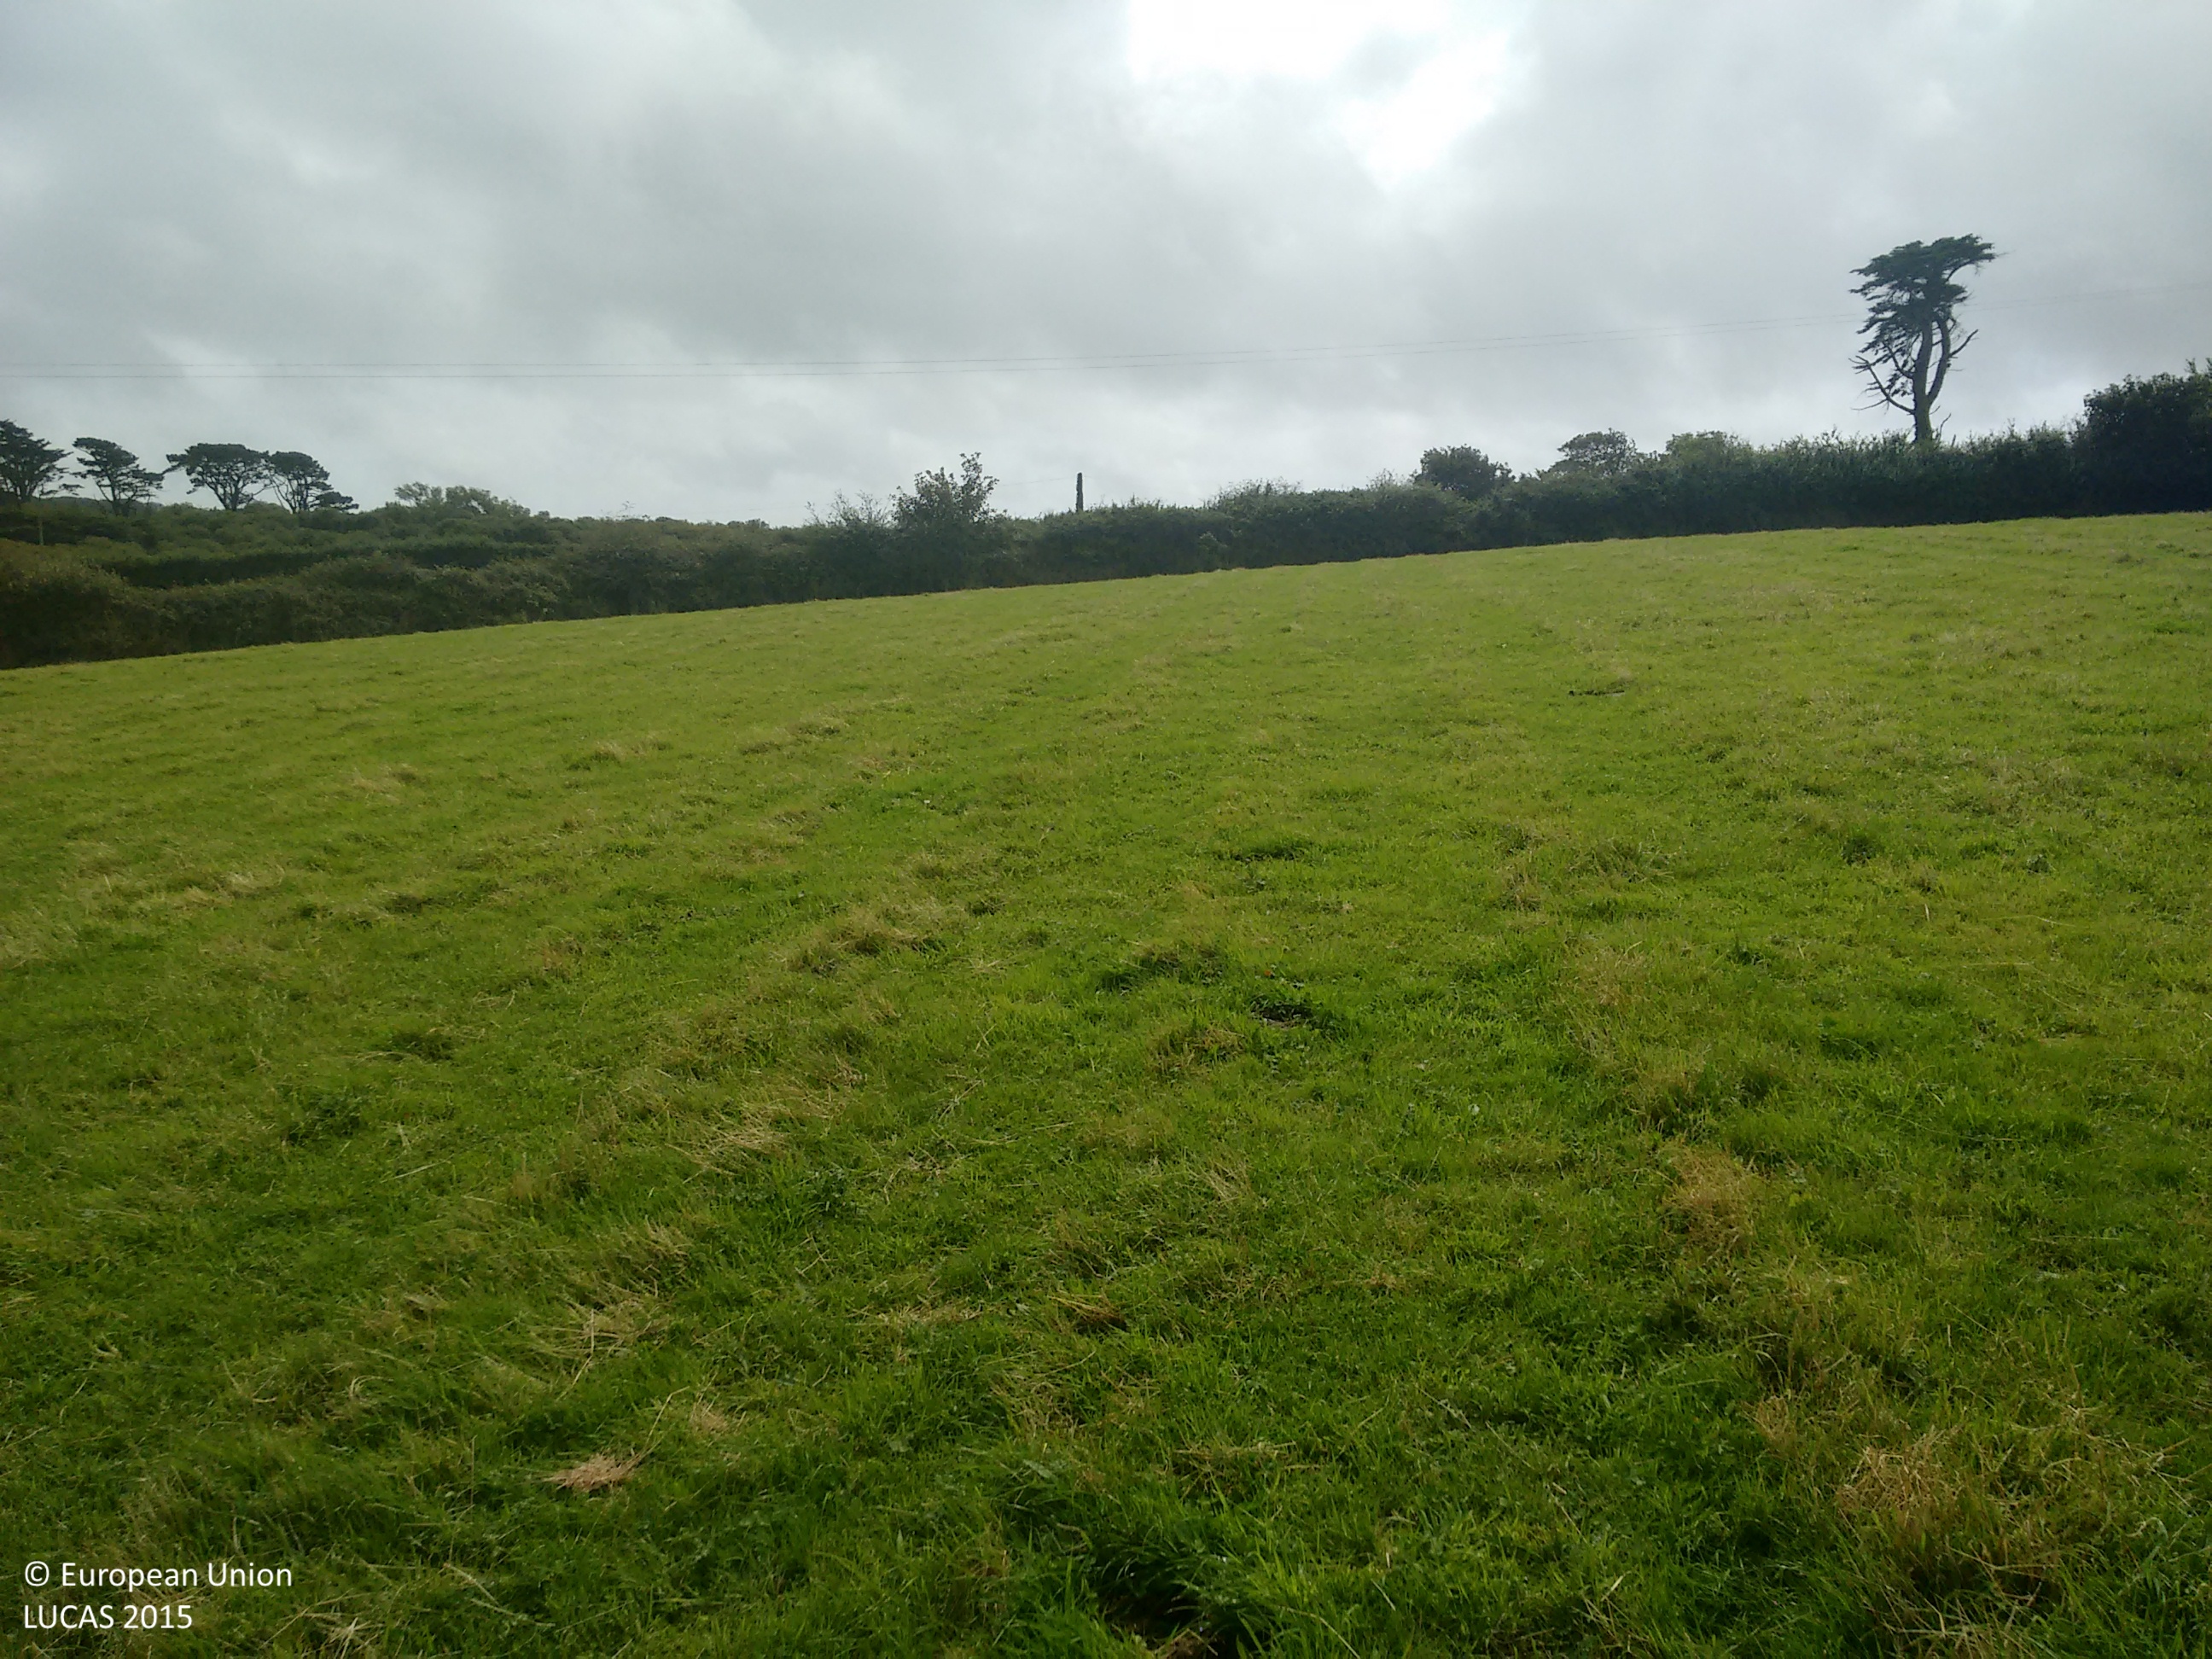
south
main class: Grassland
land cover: Grassland without tree/shrub cover
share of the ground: > 75 %
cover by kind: herbaceous plants 100 %
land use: Agriculture (excluding fallow land and kitchen gardens)
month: August
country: GB
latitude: 50.0452
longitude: -5.1298
